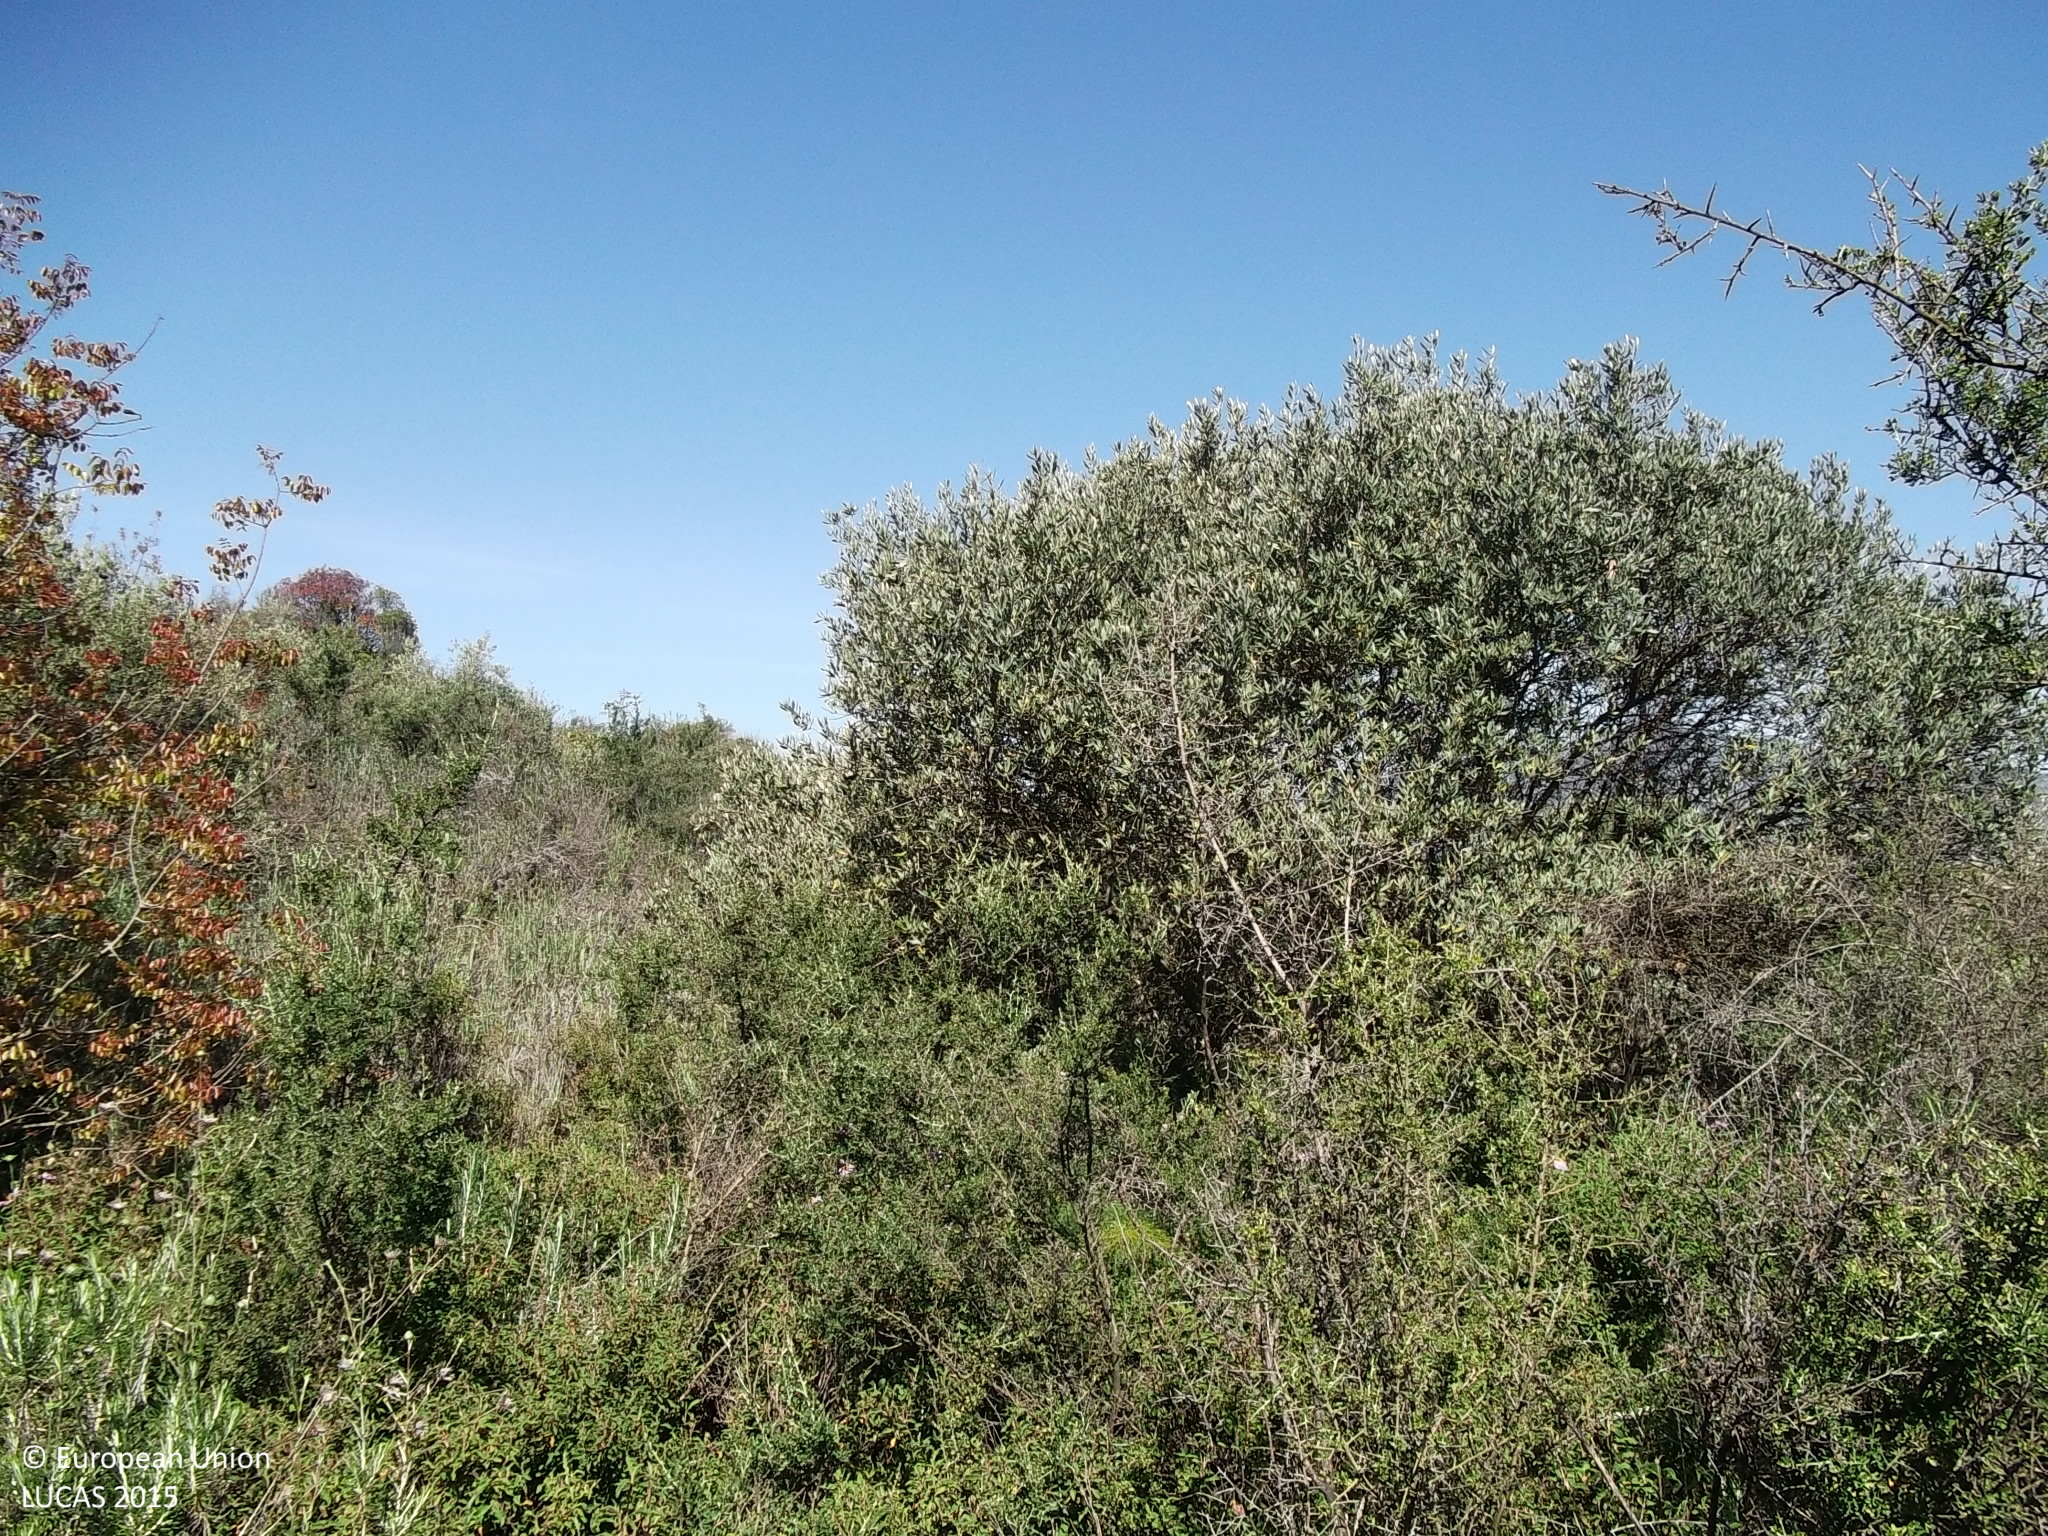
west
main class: Shrubland
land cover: Shrubland with sparse tree cover
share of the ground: > 75 %
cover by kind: shrubs 95 %, broadleaved forest trees 5 %
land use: Semi-natural and natural areas not in use
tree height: < 5 m
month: April
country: CY
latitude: 34.8259
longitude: 33.1681
